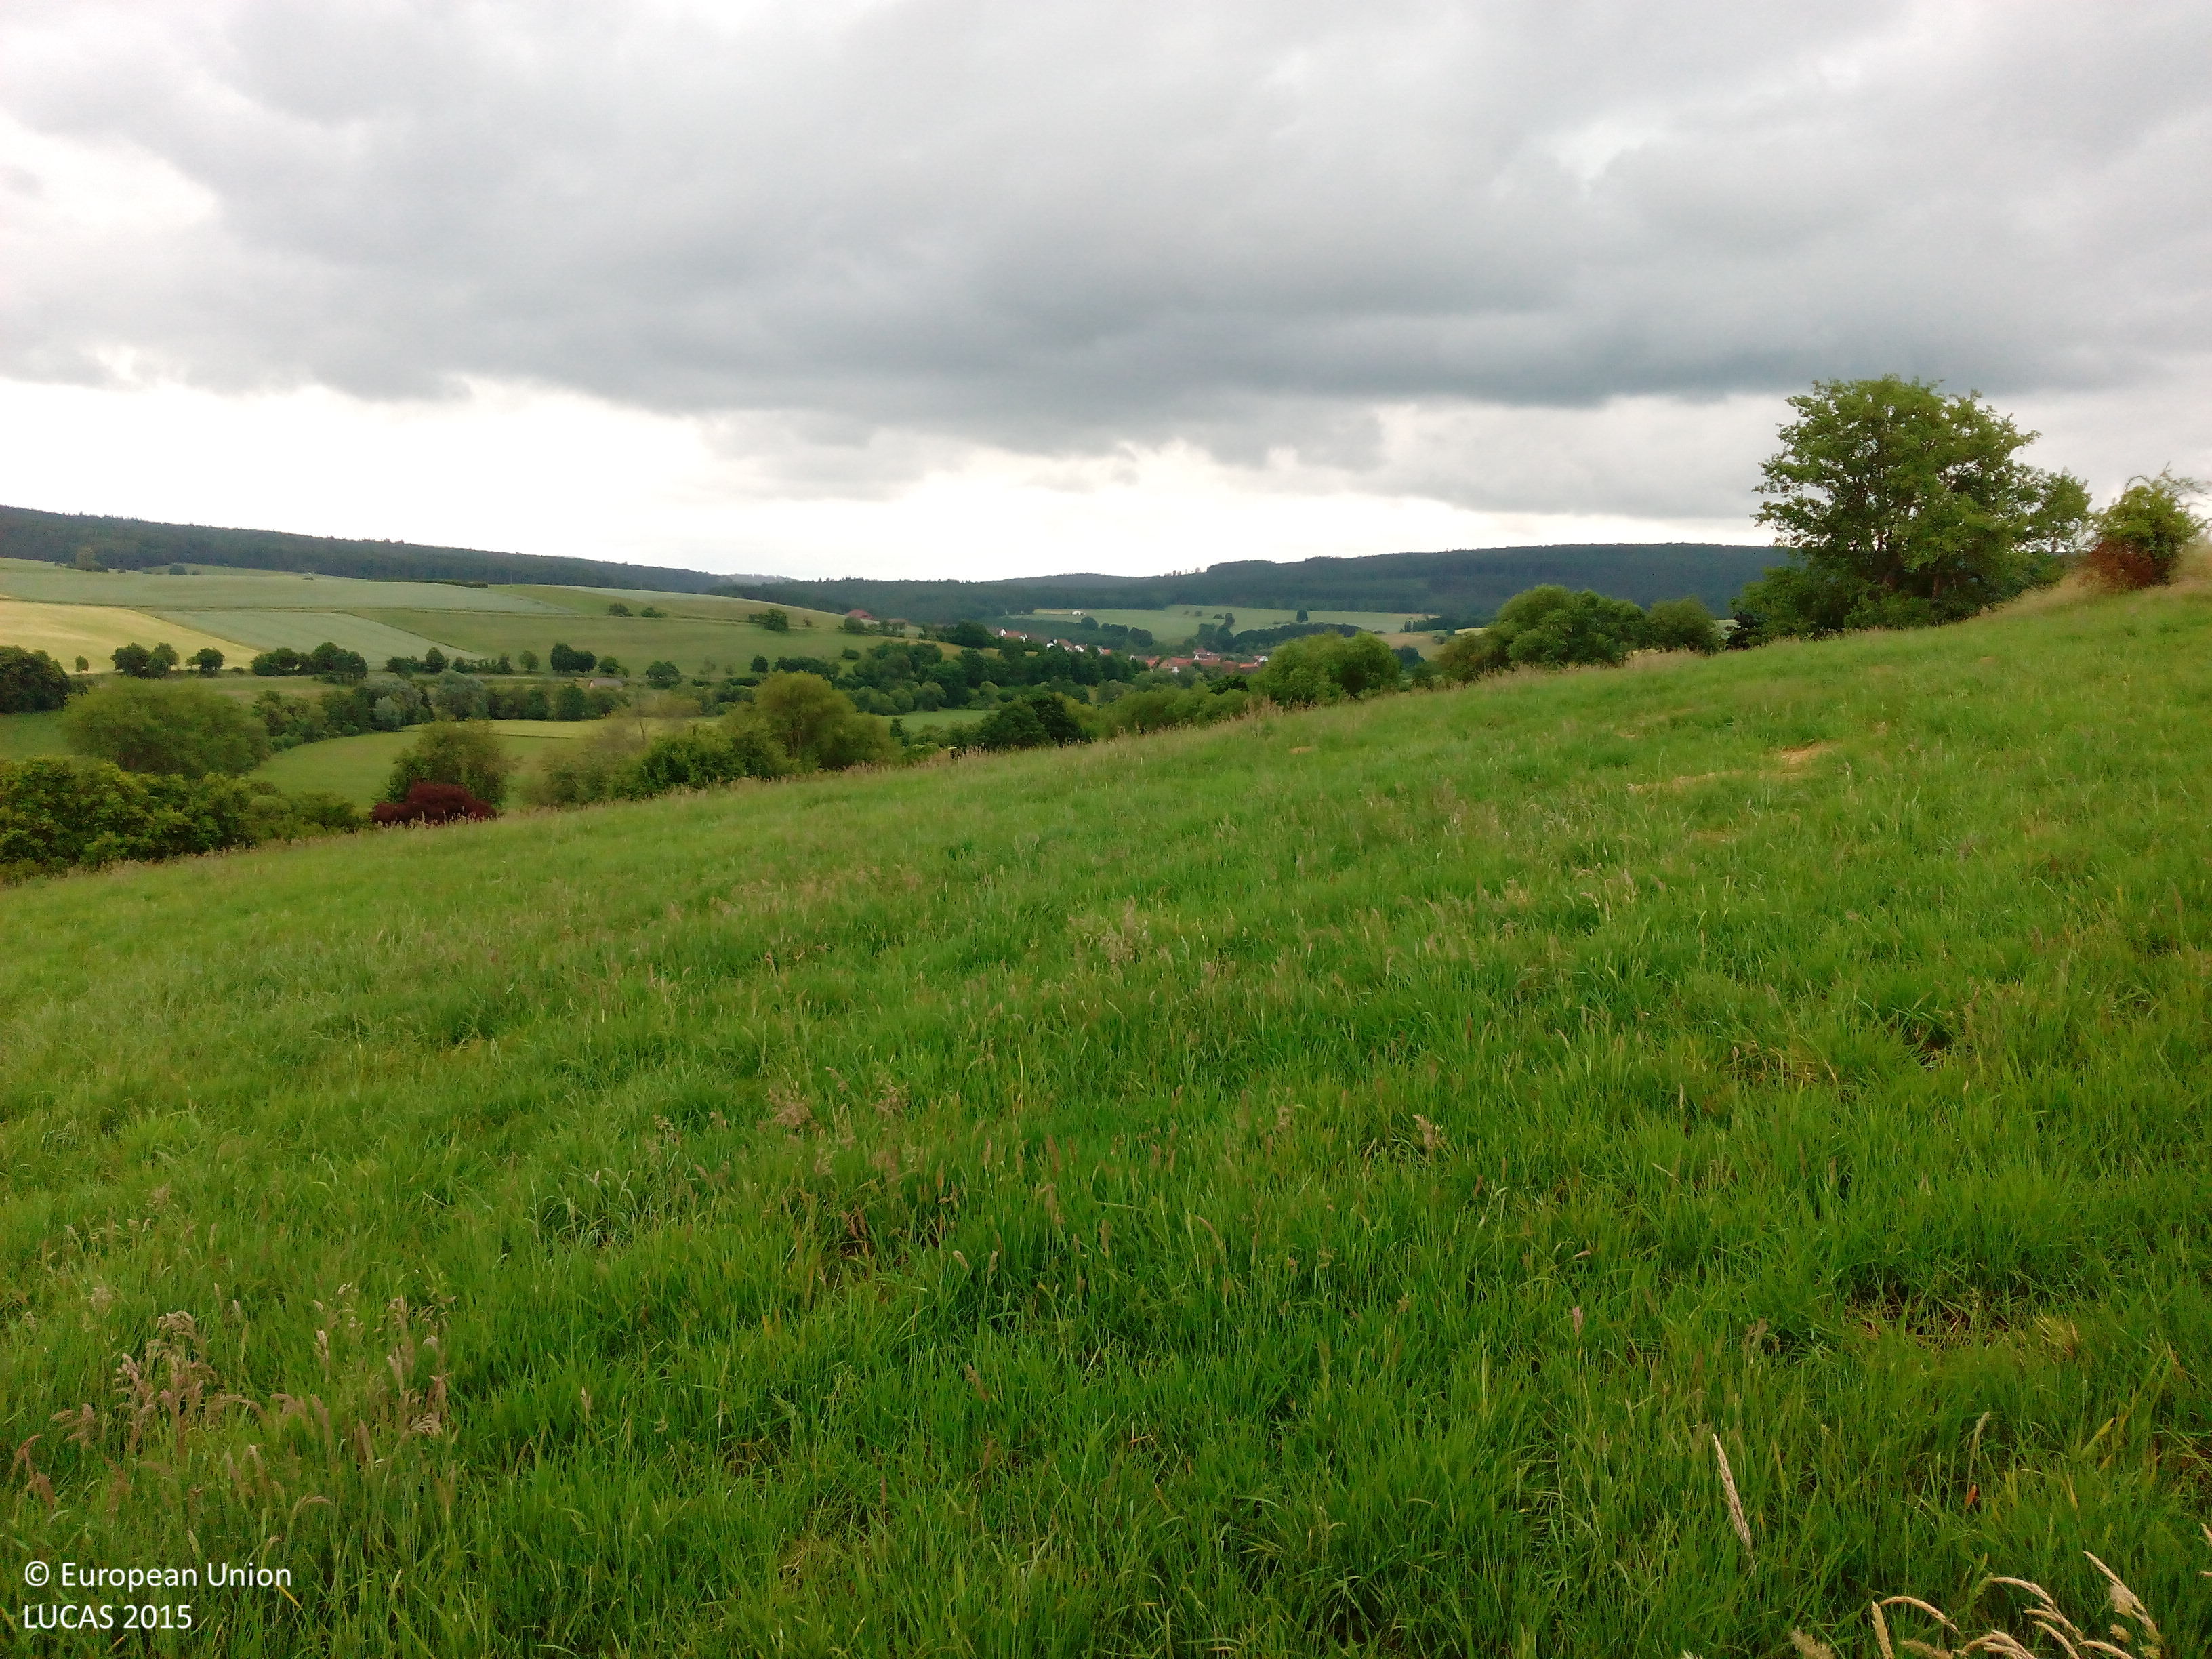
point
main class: Grassland
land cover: Grassland without tree/shrub cover
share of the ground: > 75 %
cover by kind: herbaceous plants 100 %
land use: Agriculture (excluding fallow land and kitchen gardens)
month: June
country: DE
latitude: 51.6041
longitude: 9.6680
